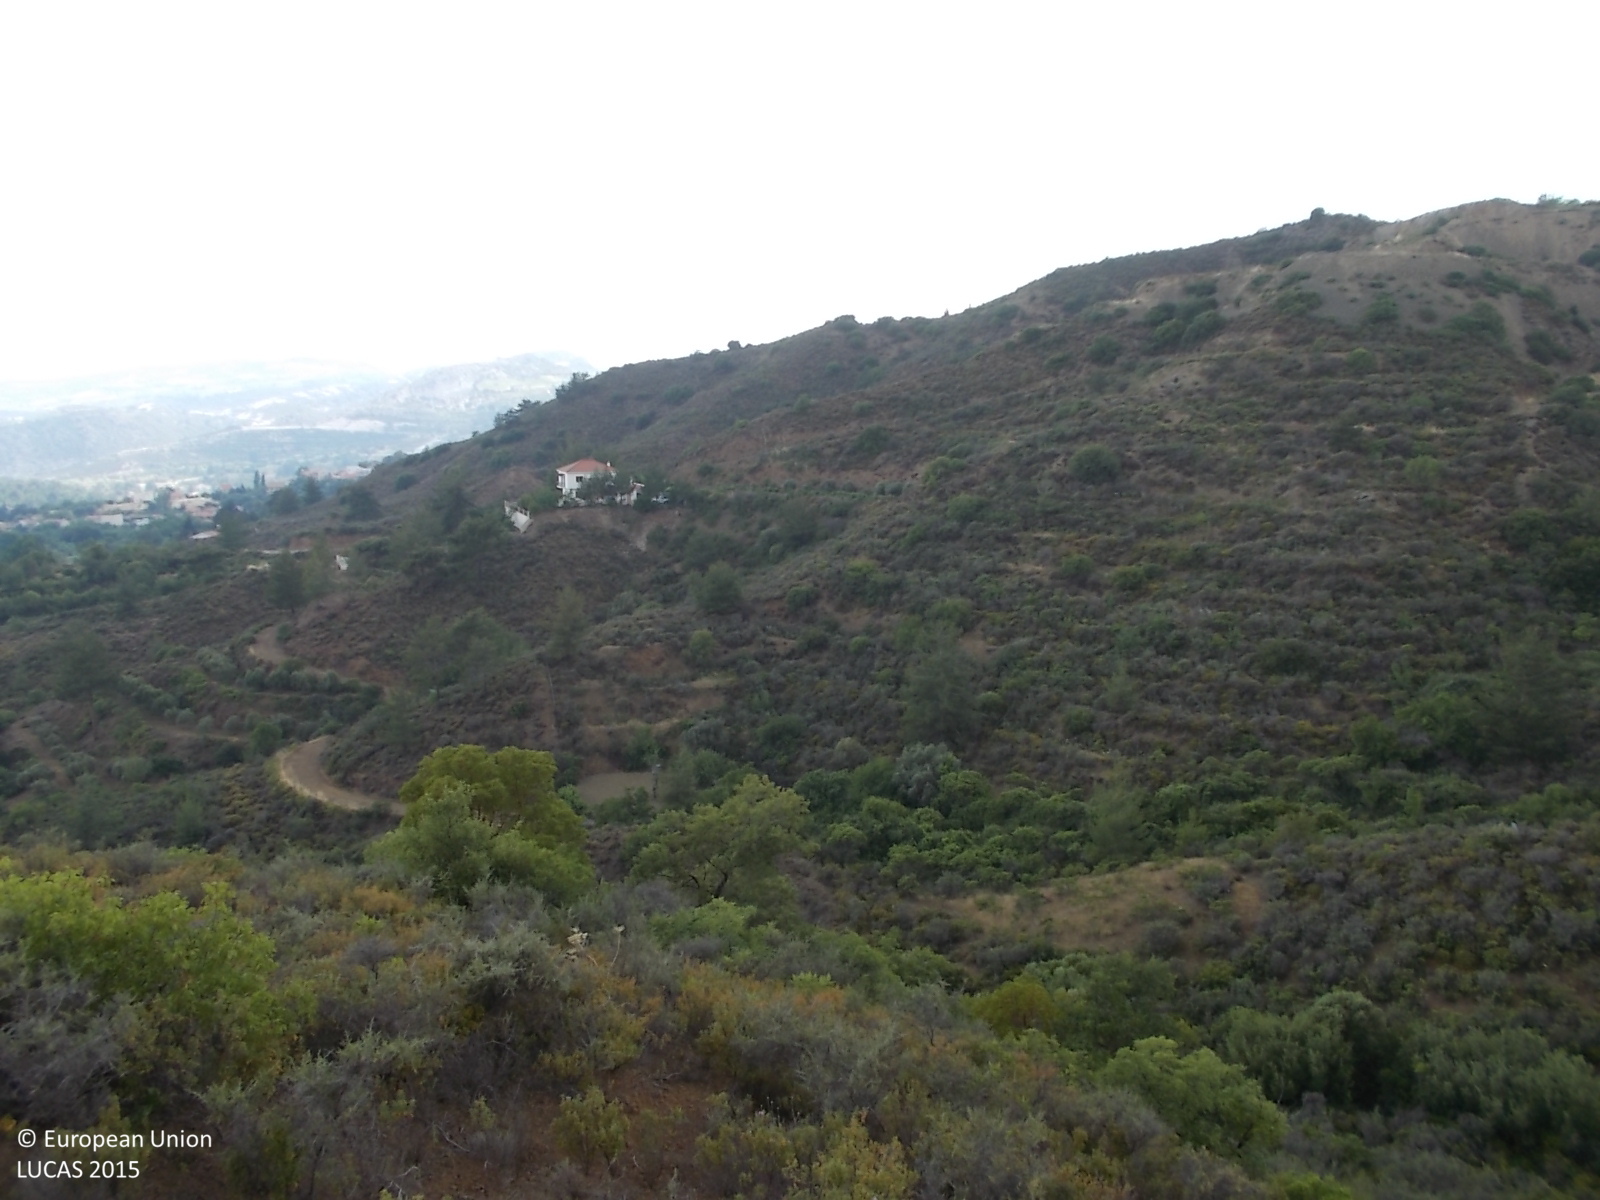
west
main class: Shrubland
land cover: Shrubland without tree cover
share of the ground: 10 - 25 %
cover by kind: unconsolidated bare surface 80 %, shrubs 20 %
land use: Semi-natural and natural areas not in use
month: June
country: CY
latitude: 34.8718
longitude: 32.8415
